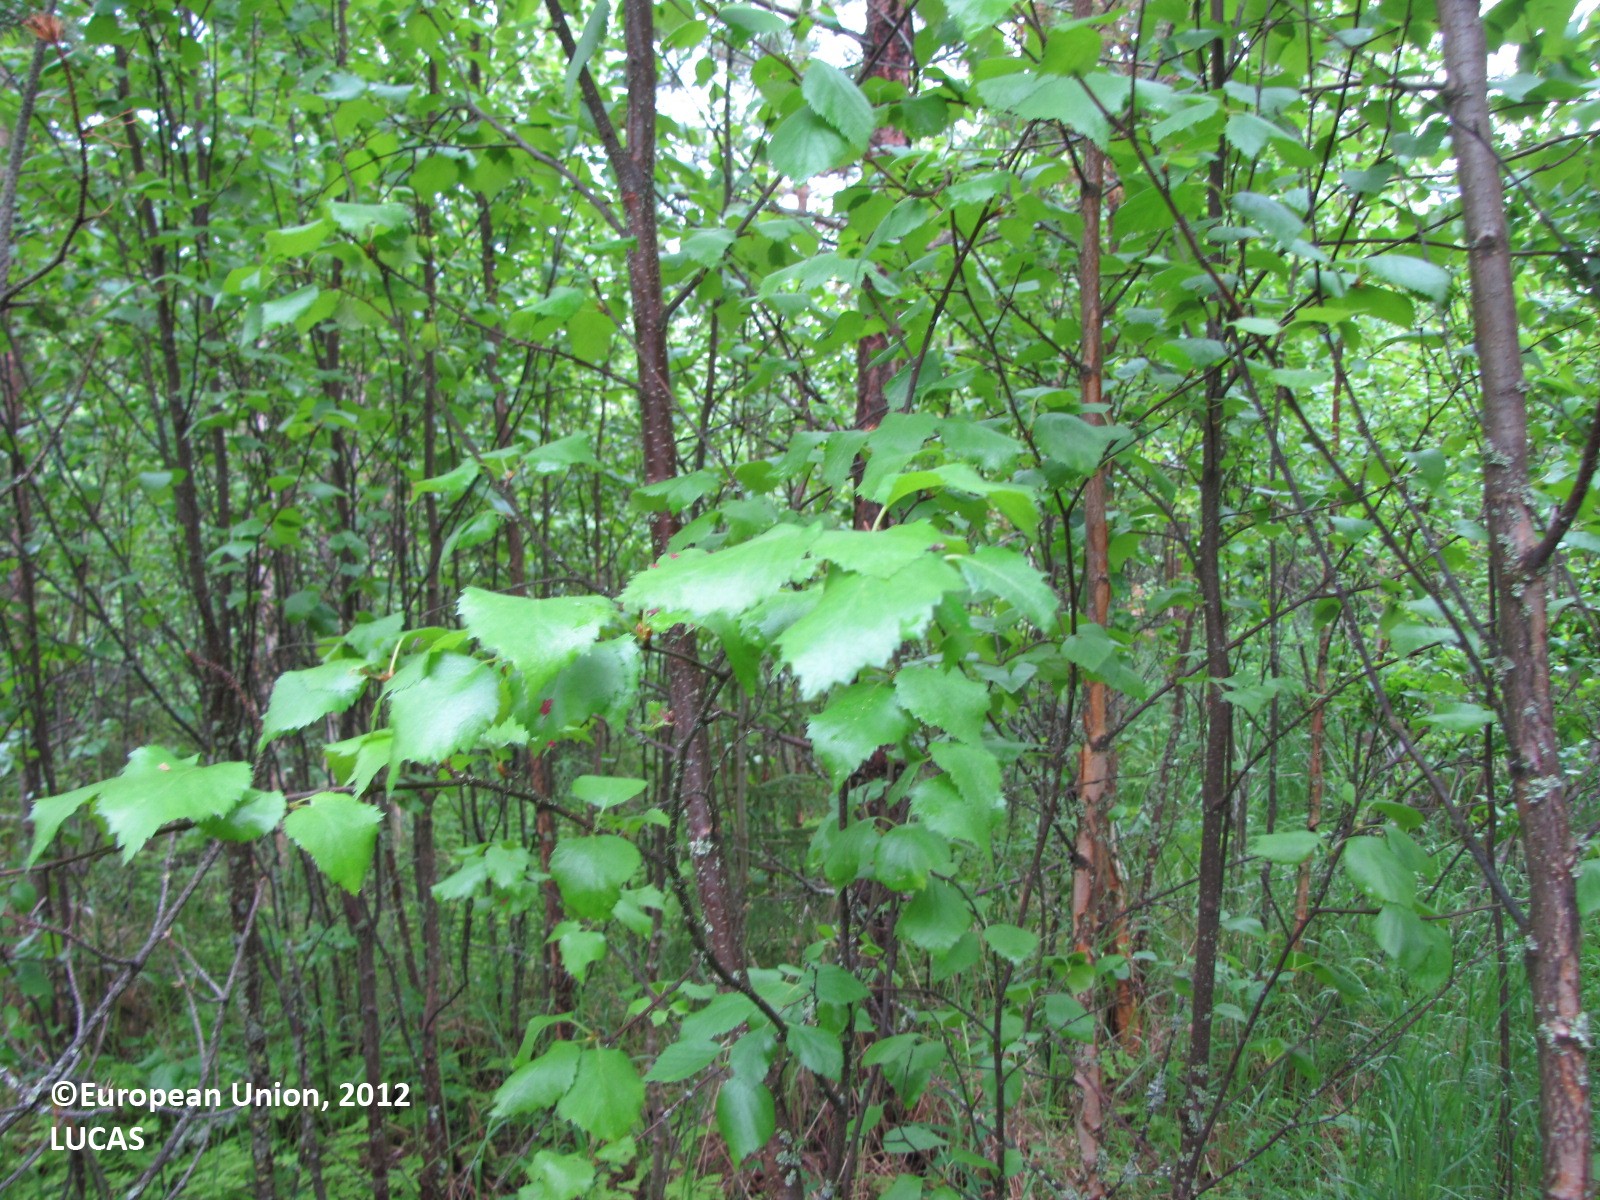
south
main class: Woodland
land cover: Other mixed woodland
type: boreal forest
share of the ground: > 75 %
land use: Forestry
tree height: > 5 m
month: June
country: FI
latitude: 66.0020
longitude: 24.4389
